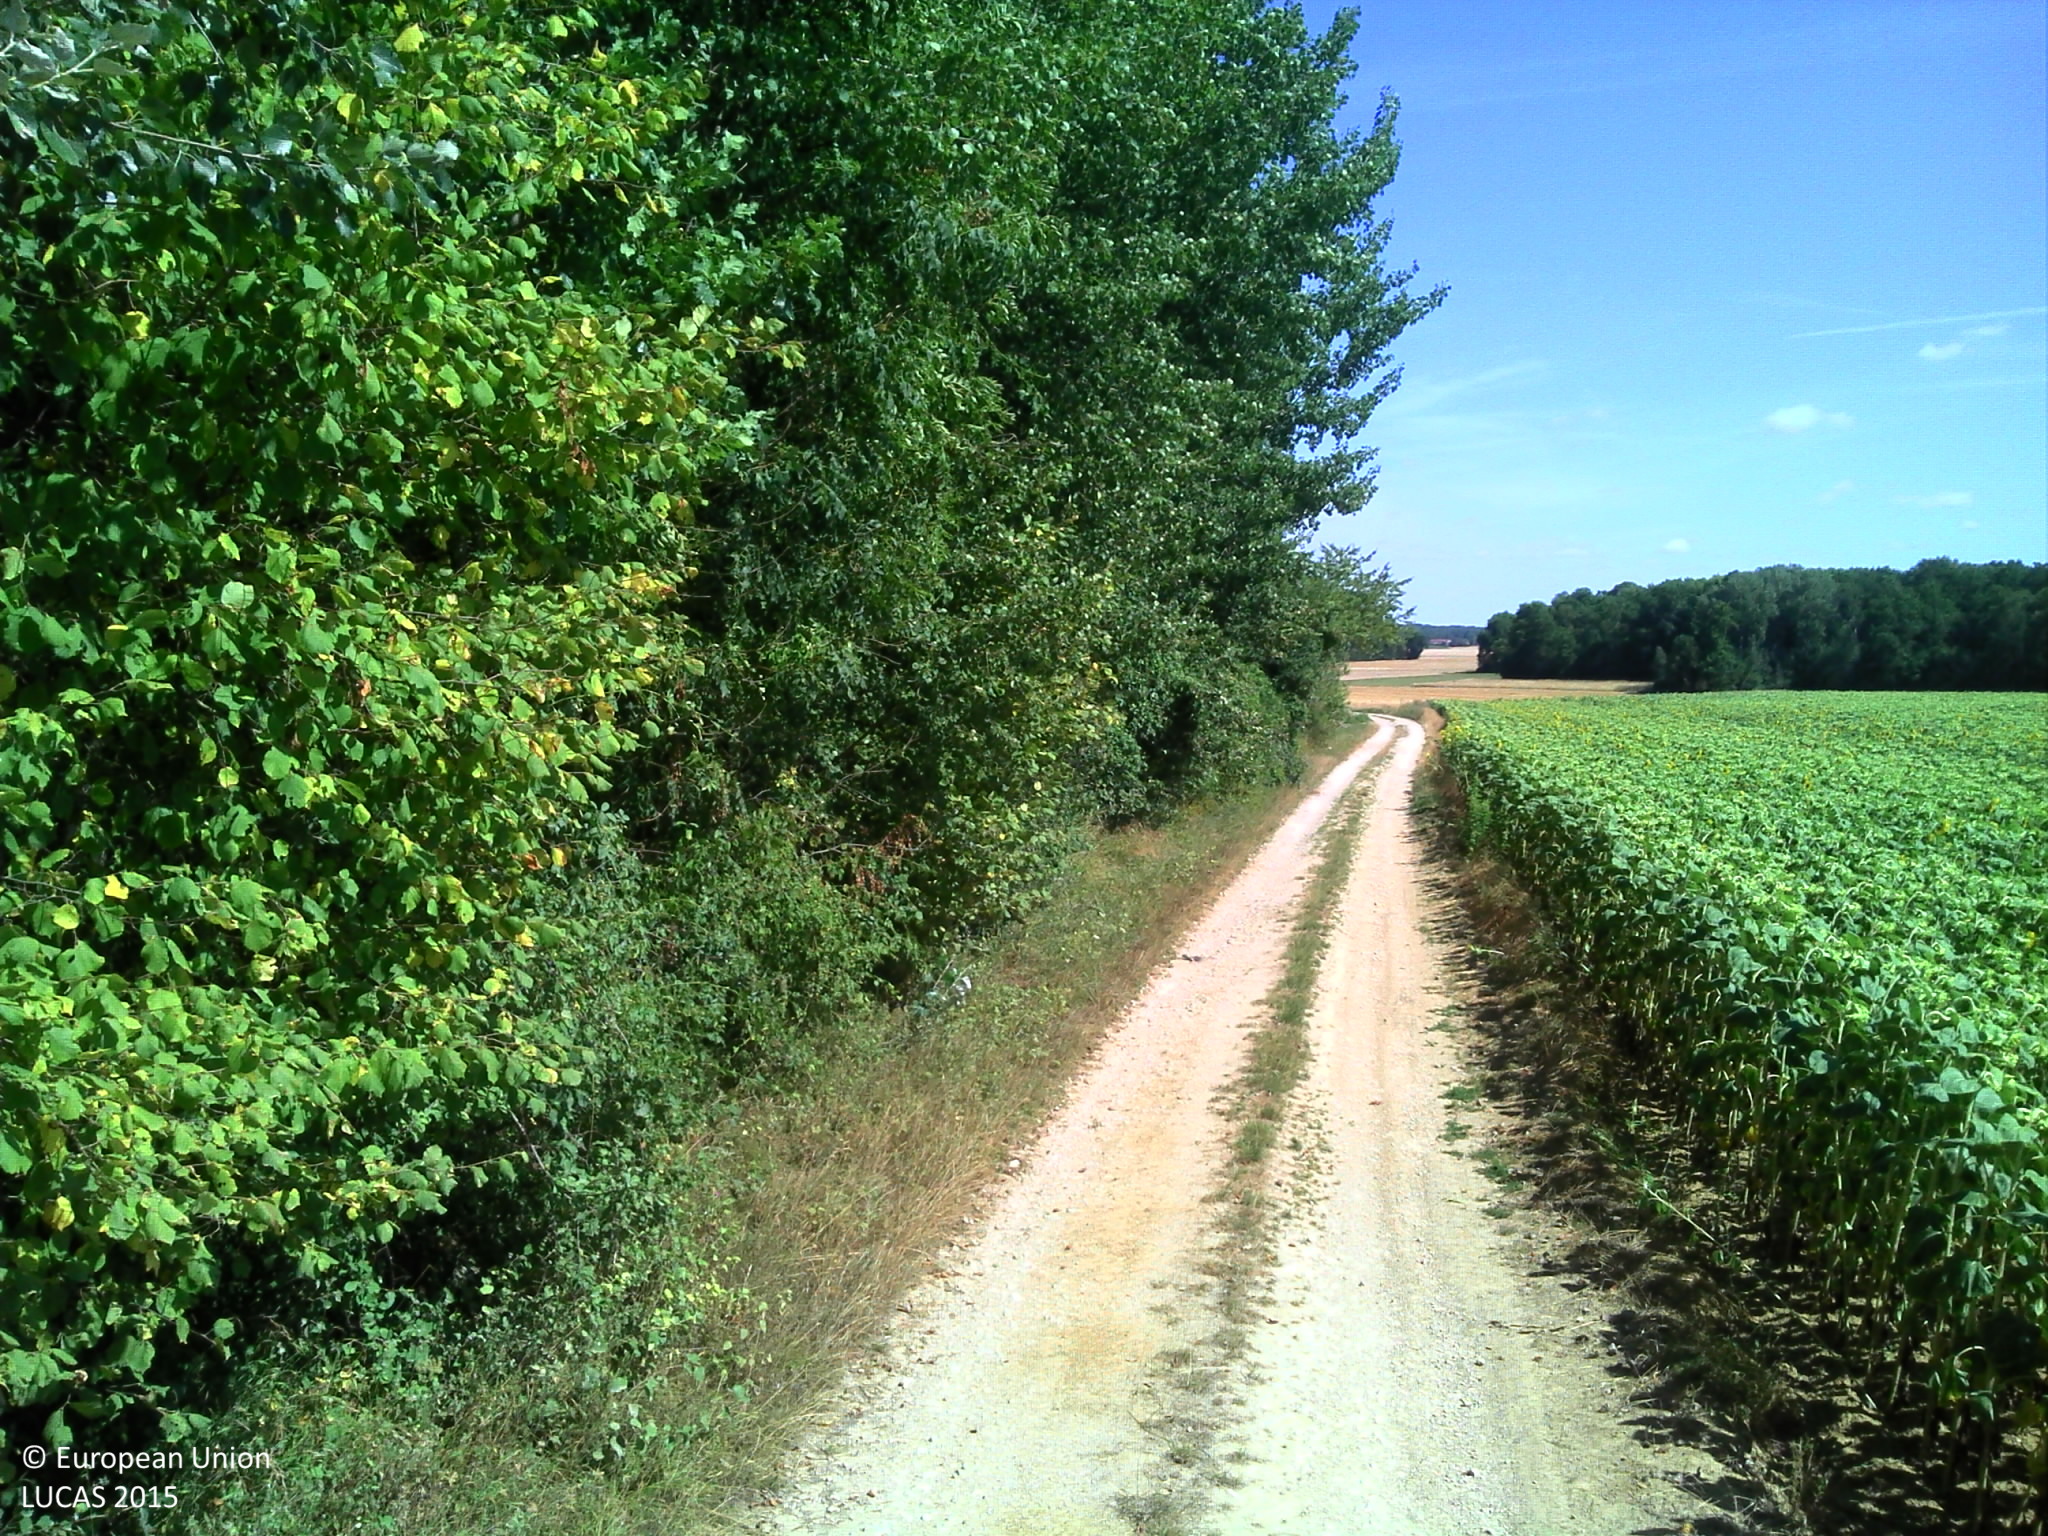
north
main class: Cropland
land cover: Sunflower
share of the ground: > 75 %
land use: Agriculture (excluding fallow land and kitchen gardens)
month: August
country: FR
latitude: 48.7249
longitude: 3.3183
